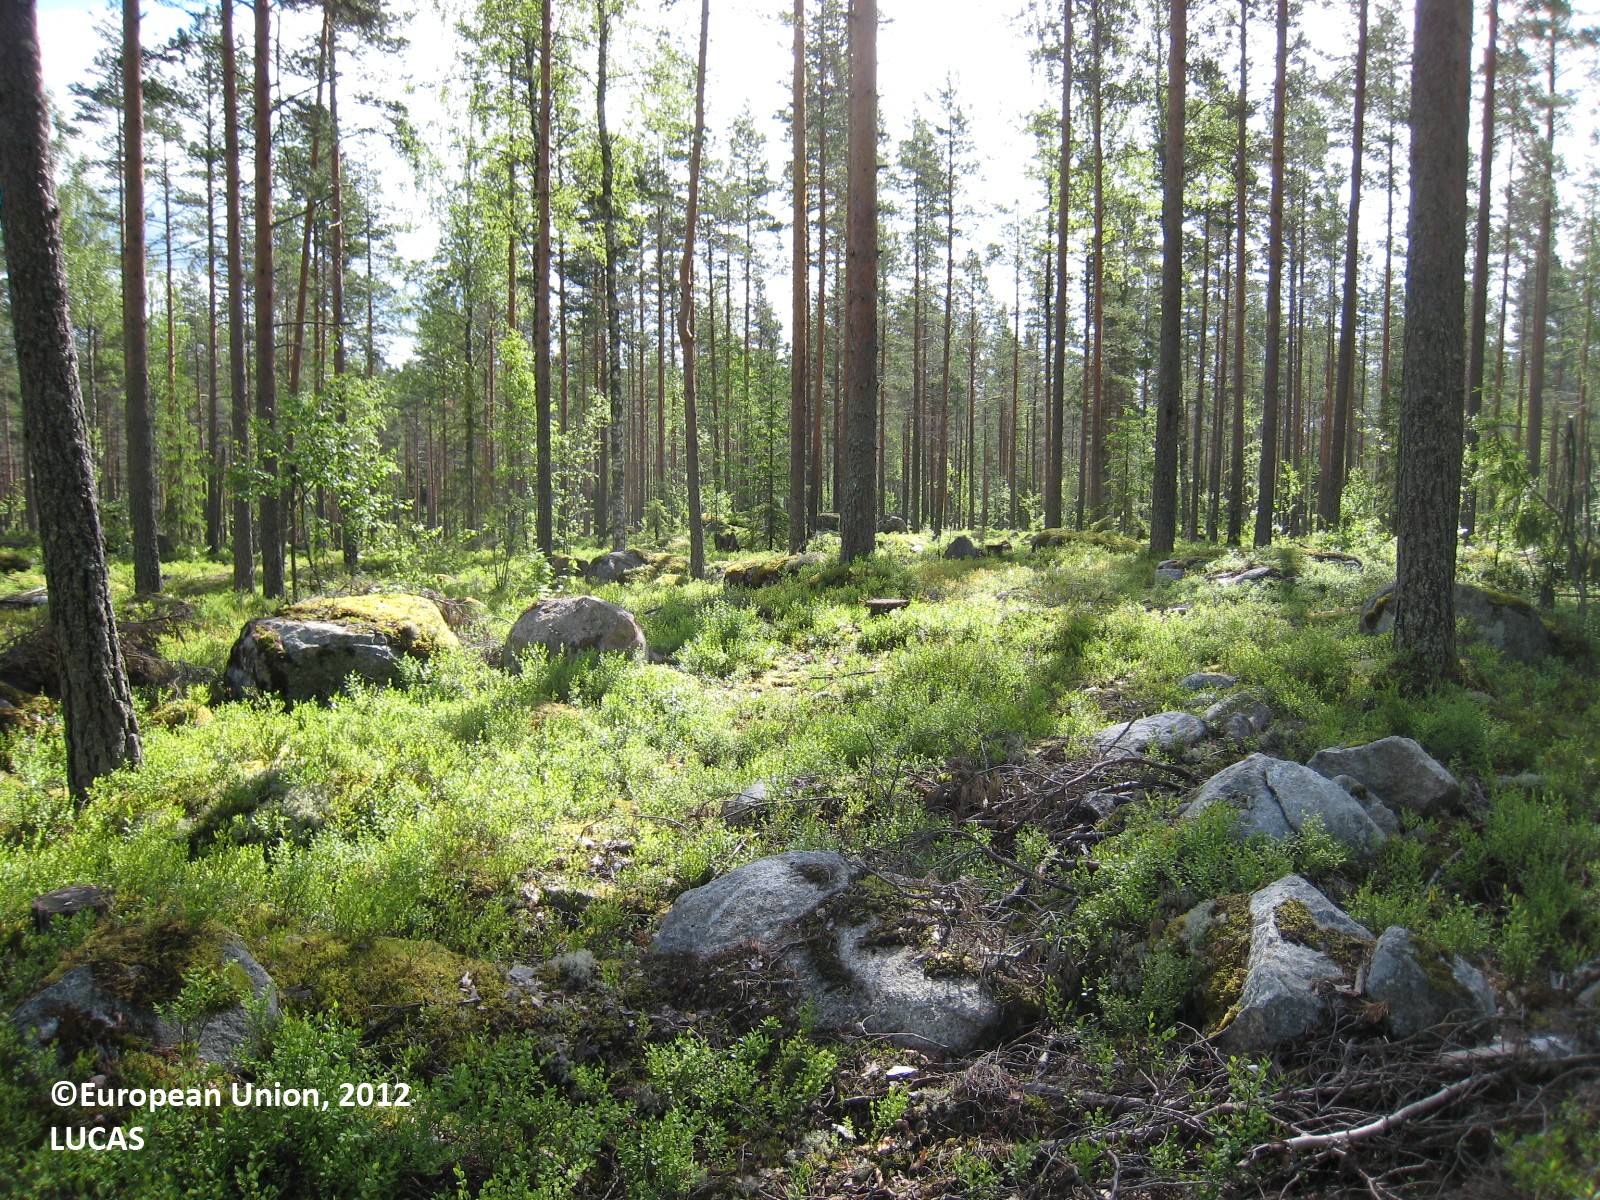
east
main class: Woodland
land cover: Pine dominated coniferous woodland
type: boreal forest
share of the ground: 25 - 50 %
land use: Forestry
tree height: > 5 m
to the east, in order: Pine dominated coniferous woodland; Ditches and canals; Managed hedges; Tracks; Managed hedges; Pine dominated mixed woodland
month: June
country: FI
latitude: 62.0968
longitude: 25.8503
